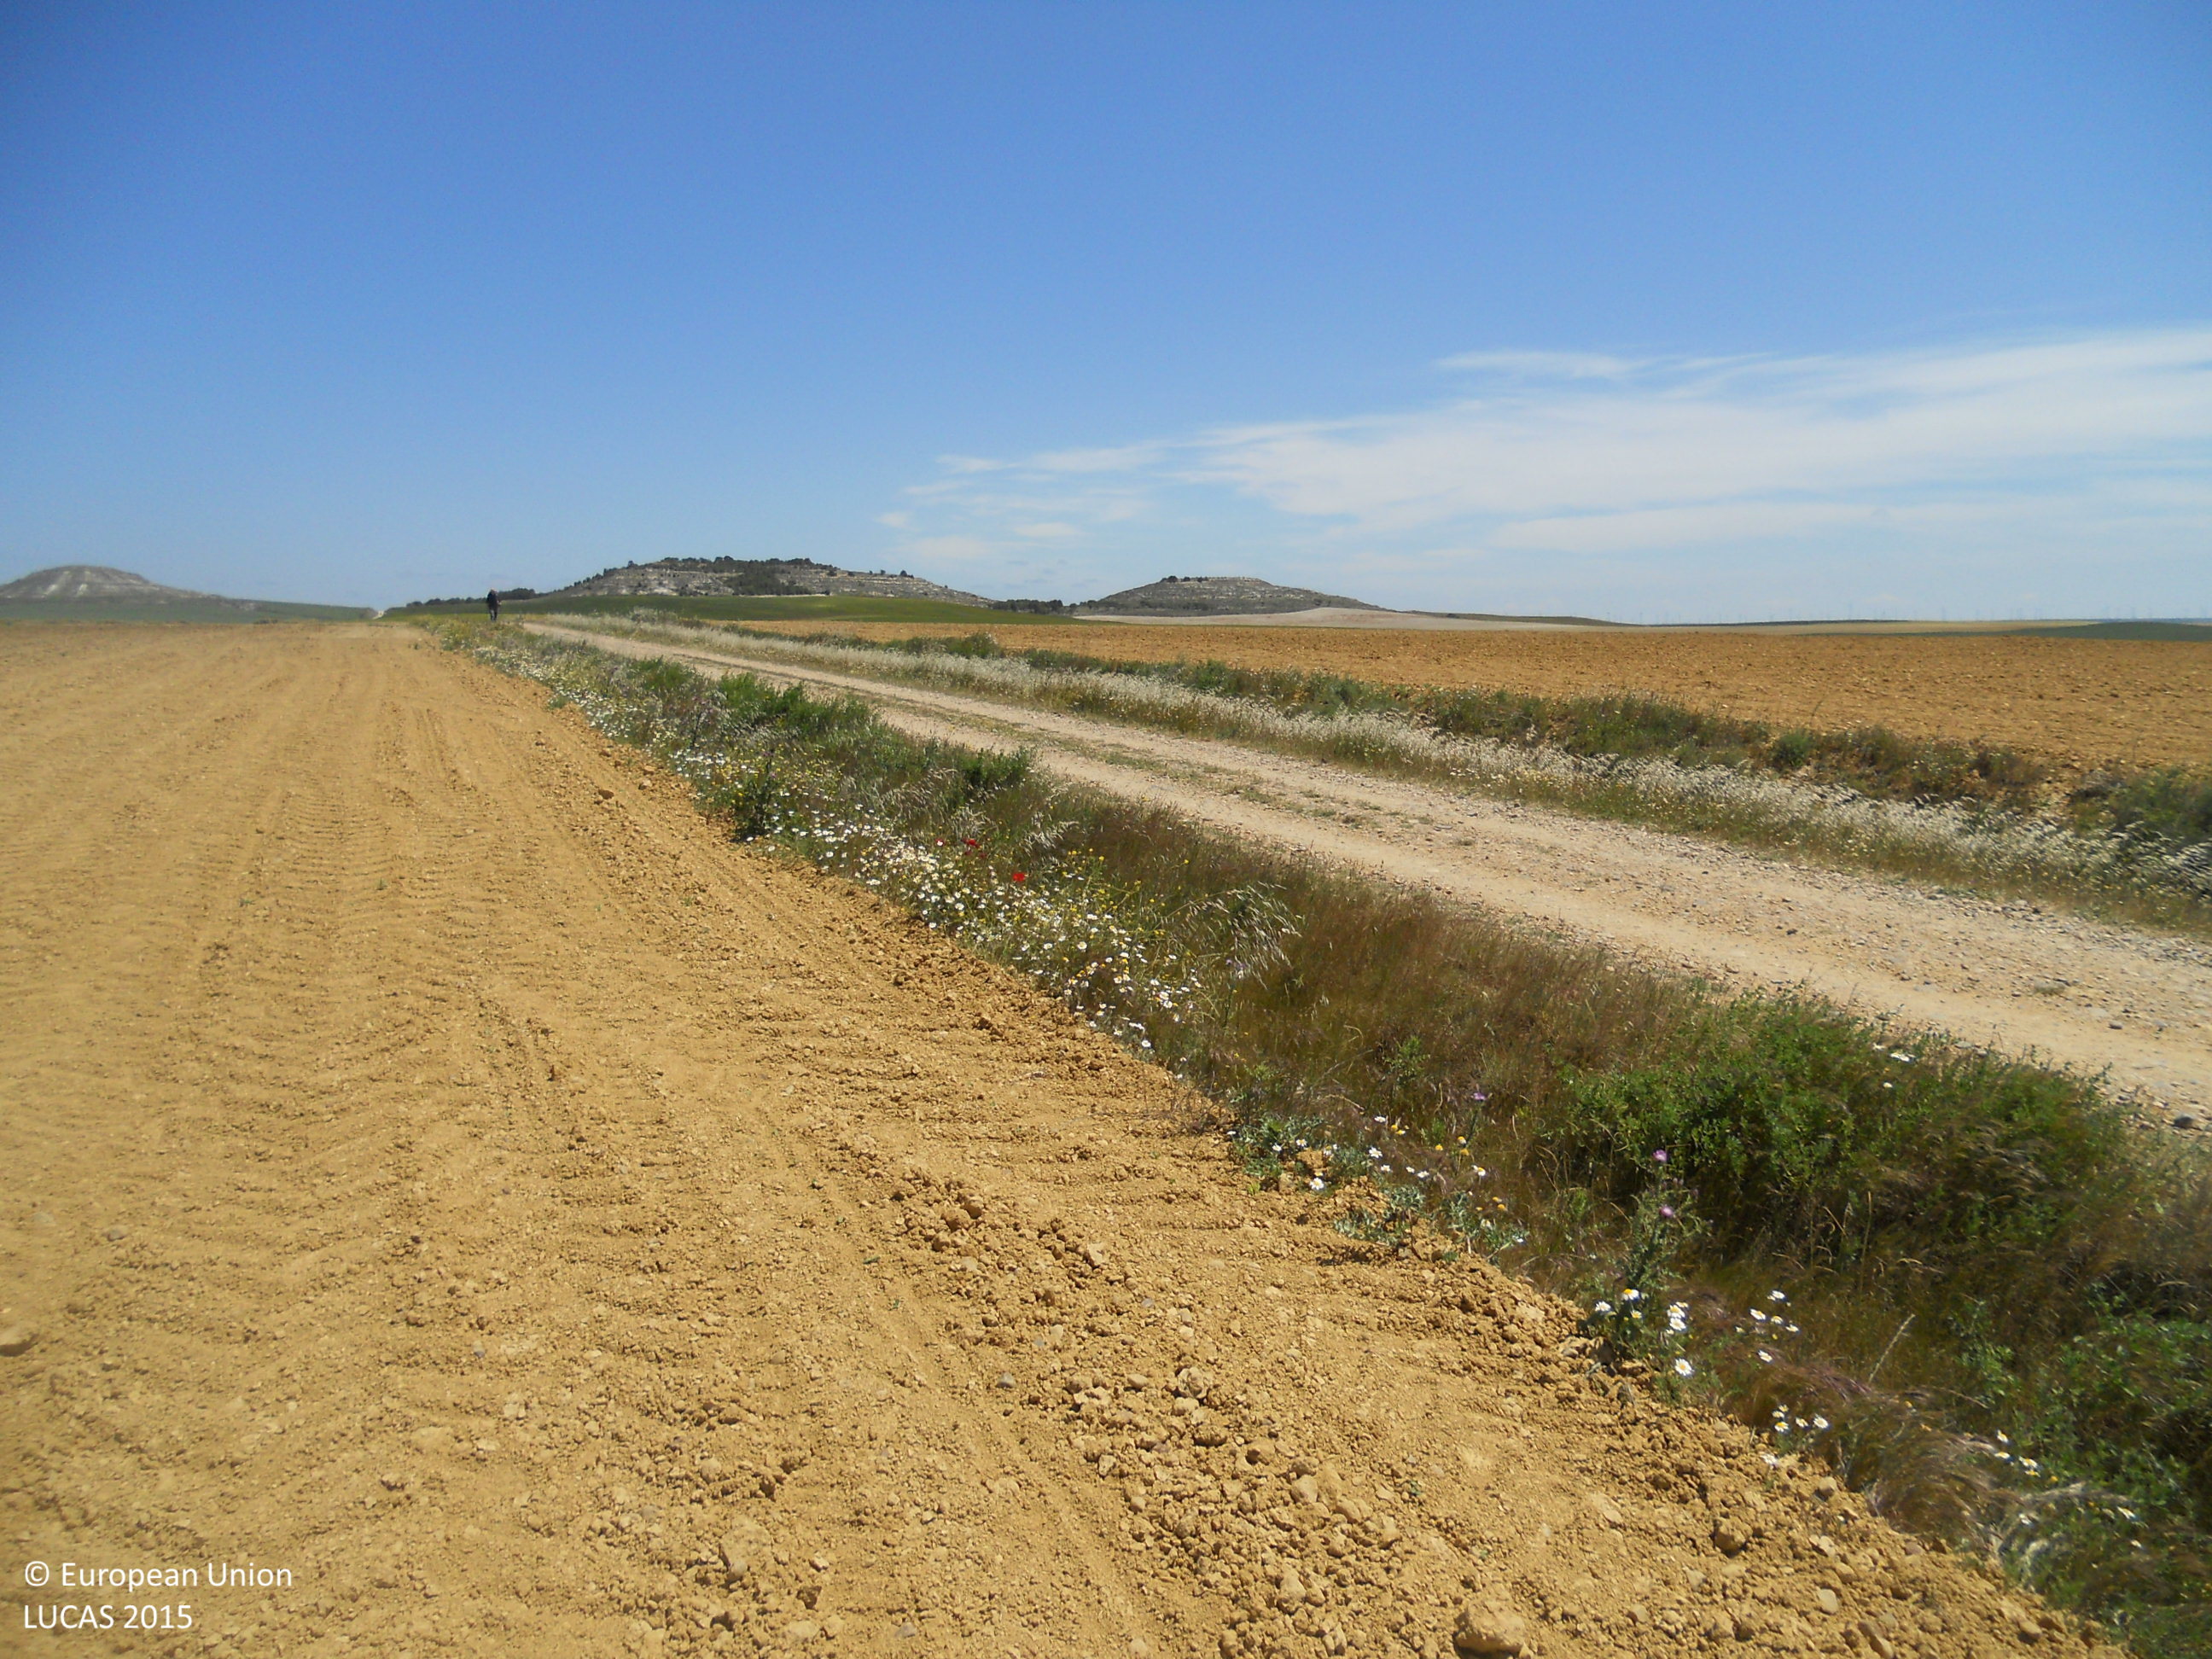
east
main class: Cropland
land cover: Sunflower
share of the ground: < 10 %
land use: Agriculture (excluding fallow land and kitchen gardens)
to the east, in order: Sunflower; Grass margins; Tracks; Grass margins; Sunflower
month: May
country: ES
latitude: 42.2720
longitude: -4.3160
